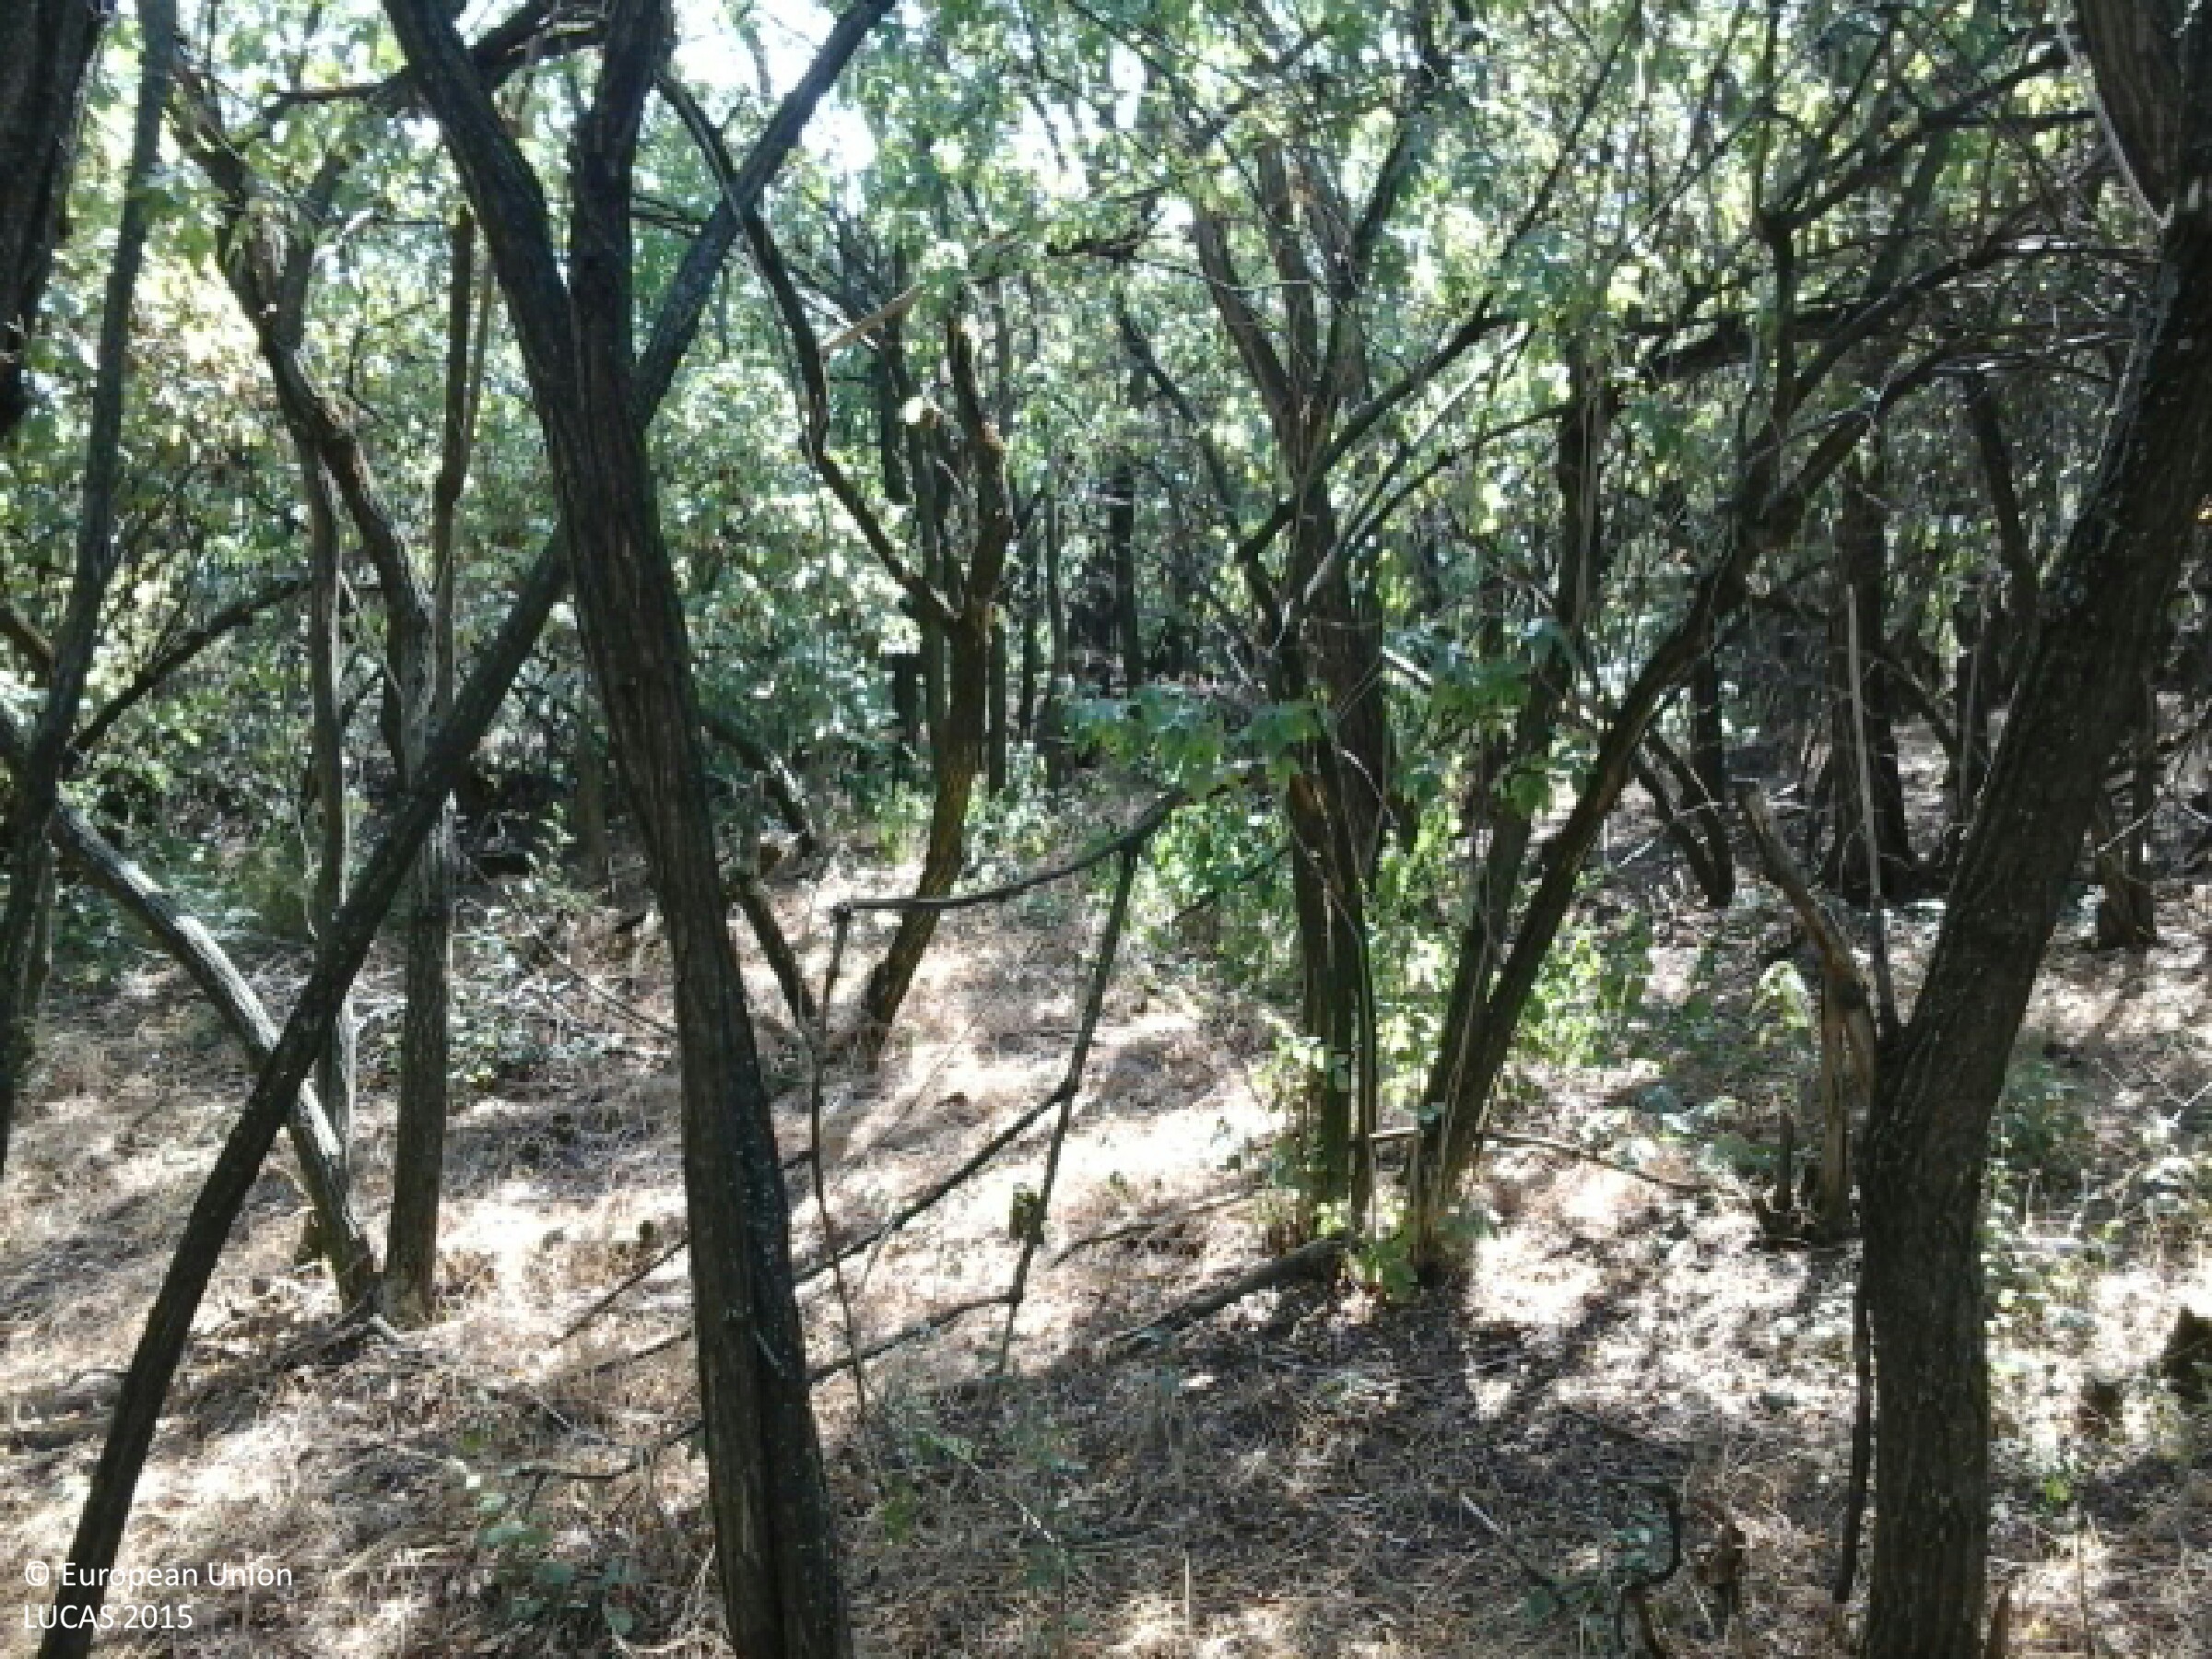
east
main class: Woodland
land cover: Broadleaved woodland
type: mesophytic deciduous forest
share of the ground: > 75 %
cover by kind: broadleaved forest trees 100 %
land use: Forestry
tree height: > 5 m
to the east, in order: Broadleaved woodland; Ditches and canals; Broadleaved woodland; Maize
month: July
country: HU
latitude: 48.1689
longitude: 21.1072
